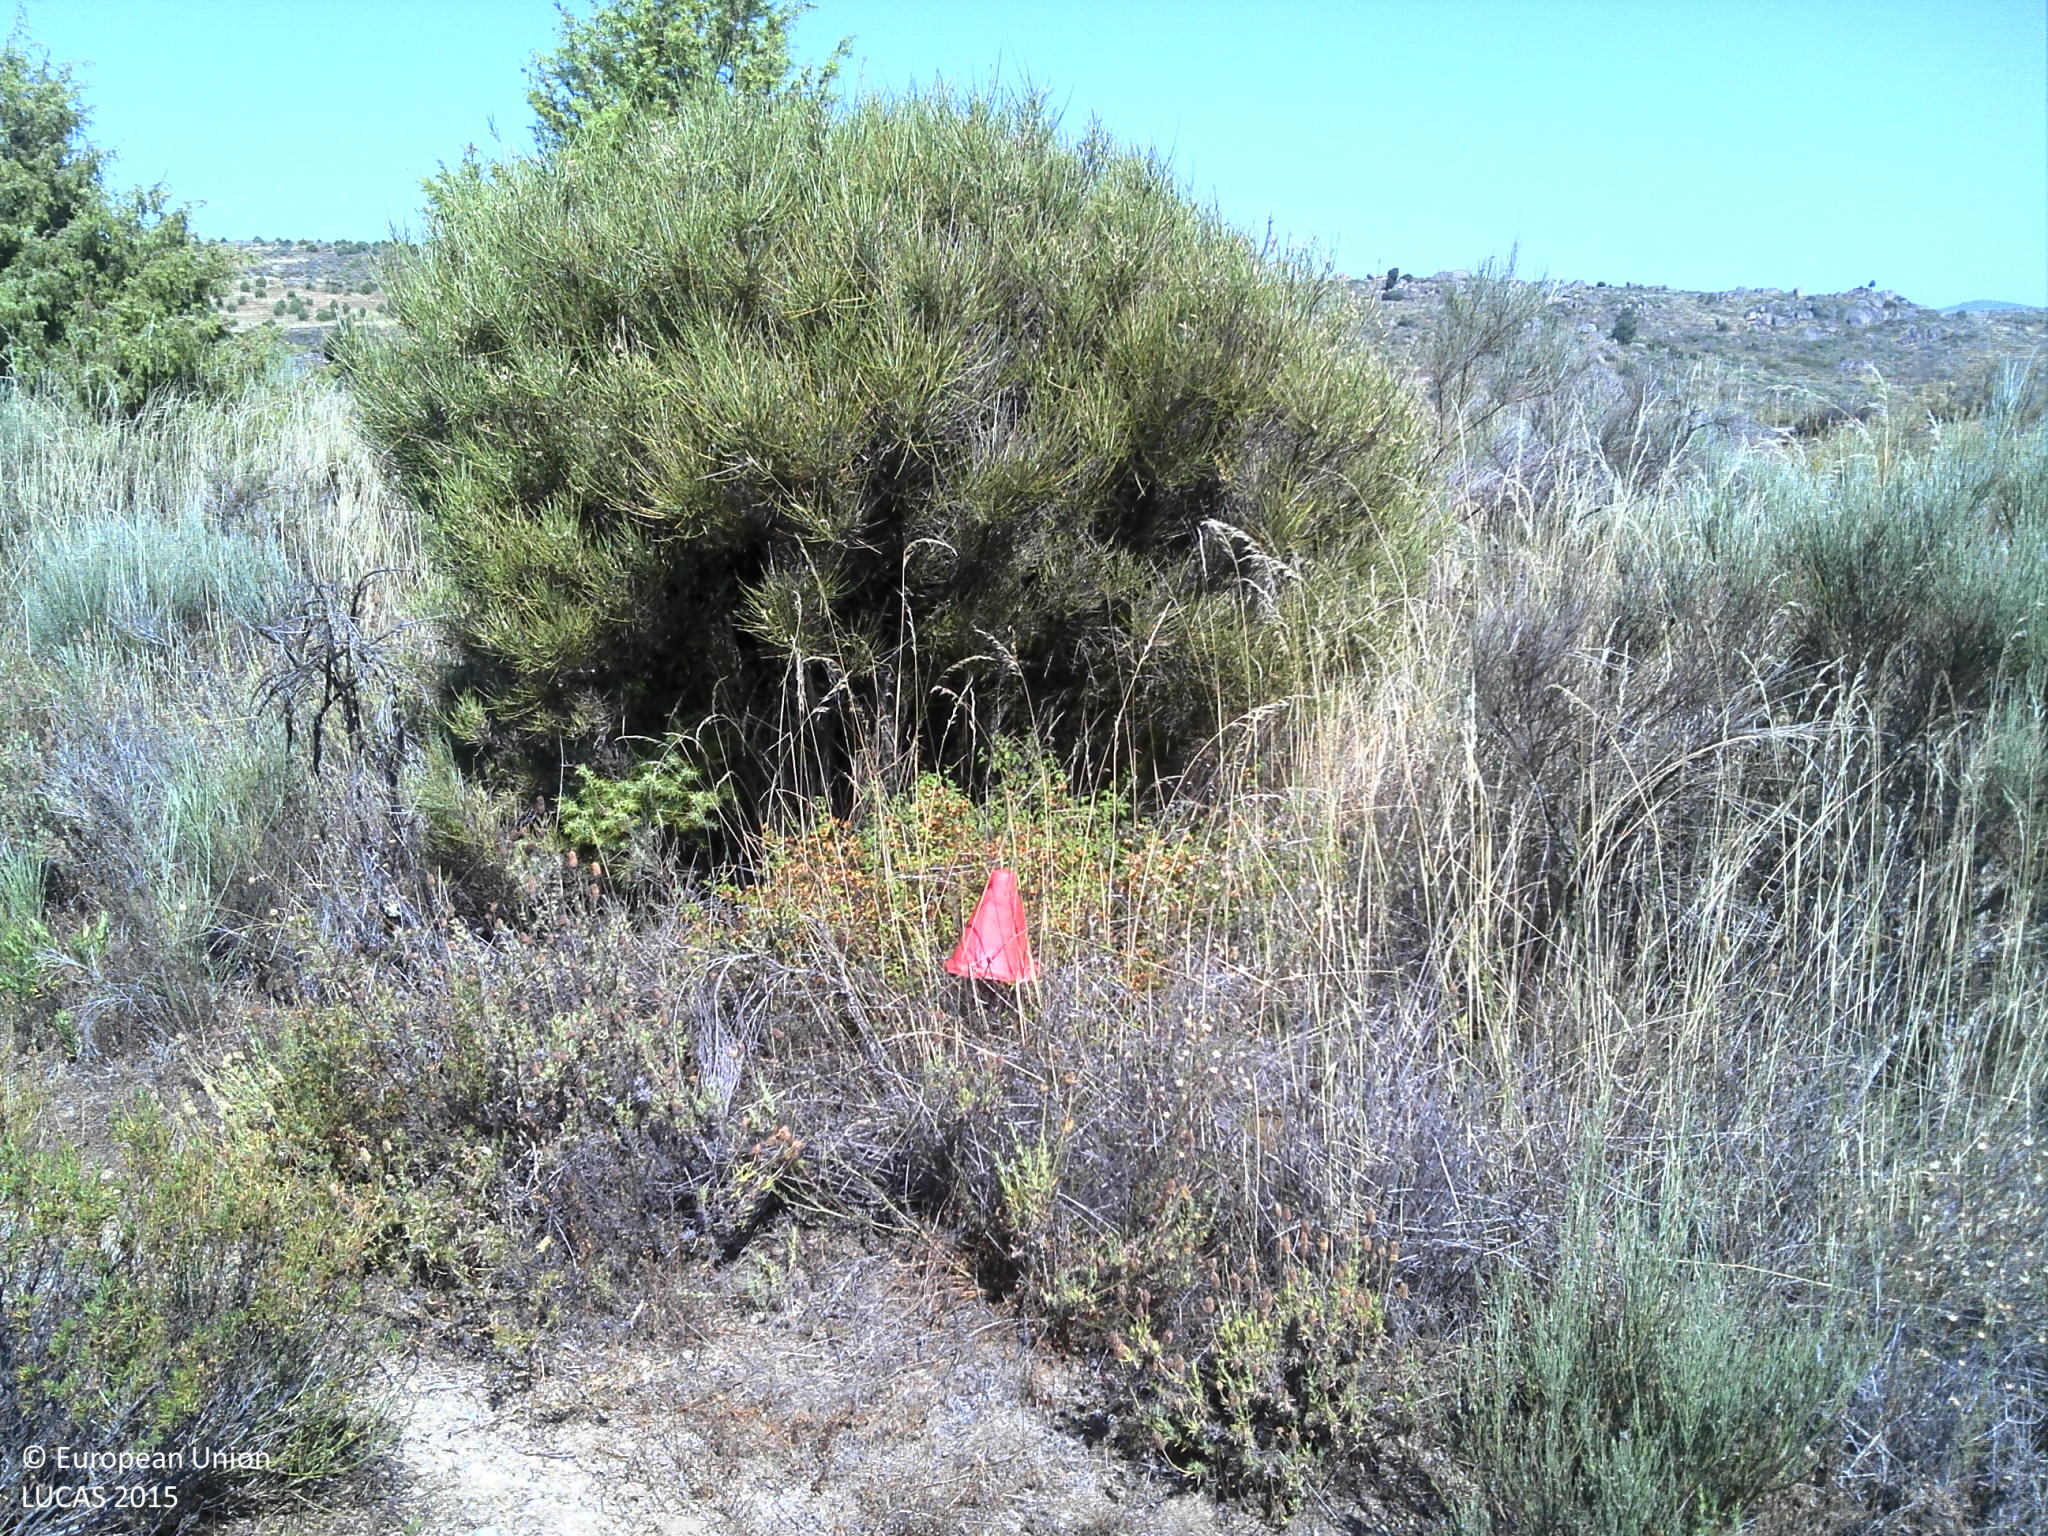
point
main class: Shrubland
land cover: Shrubland with sparse tree cover
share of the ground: > 75 %
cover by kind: shrubs 95 %, coniferous forest trees 5 %
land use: Semi-natural and natural areas not in use
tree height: < 5 m
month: June
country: PT
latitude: 40.9475
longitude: -6.8885
